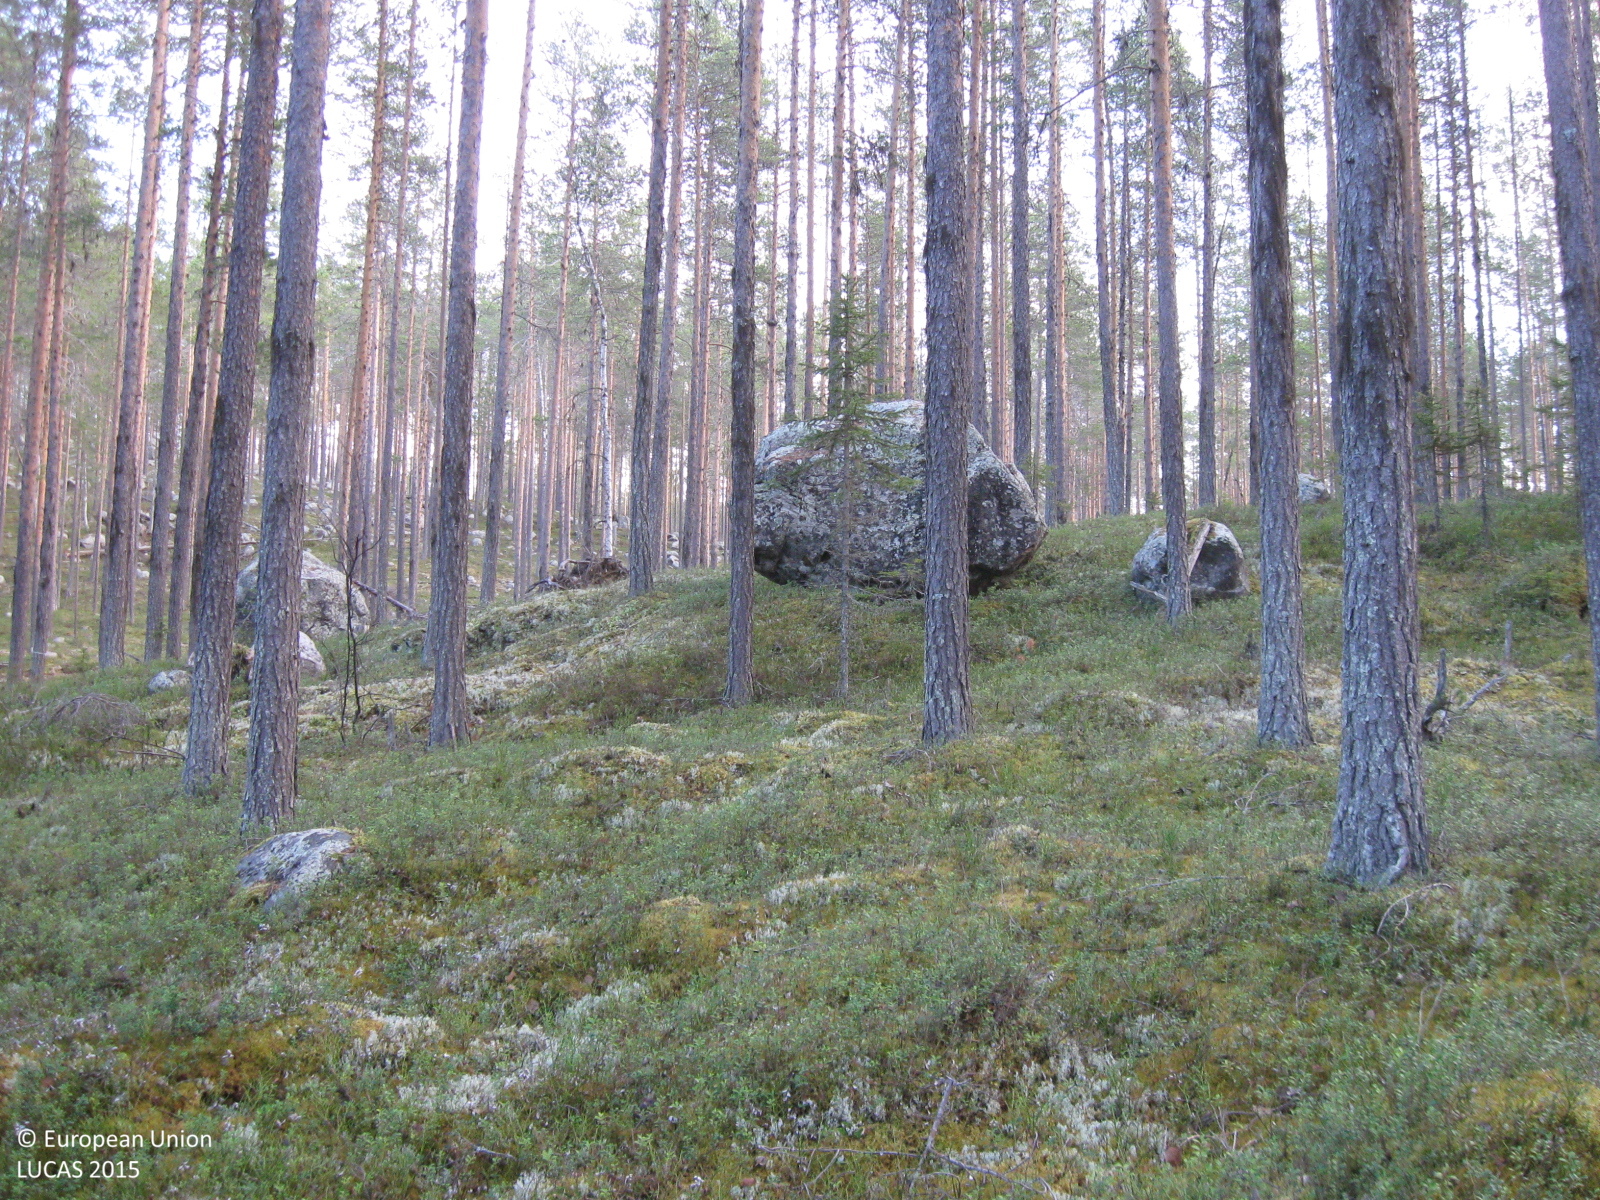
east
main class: Woodland
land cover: Pine dominated coniferous woodland
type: boreal forest
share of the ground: 50 - 75 %
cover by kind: coniferous forest trees 65 %, shrubs 10 %, herbaceous plants 10 %, lichens and mosses 10 %, unconsolidated bare surface 5 %
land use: Forestry
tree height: > 5 m
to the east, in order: Pine dominated coniferous woodland; Tracks; Pine dominated coniferous woodland; Tracks; Pine dominated coniferous woodland
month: November
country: SE
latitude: 66.1406
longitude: 20.9296
